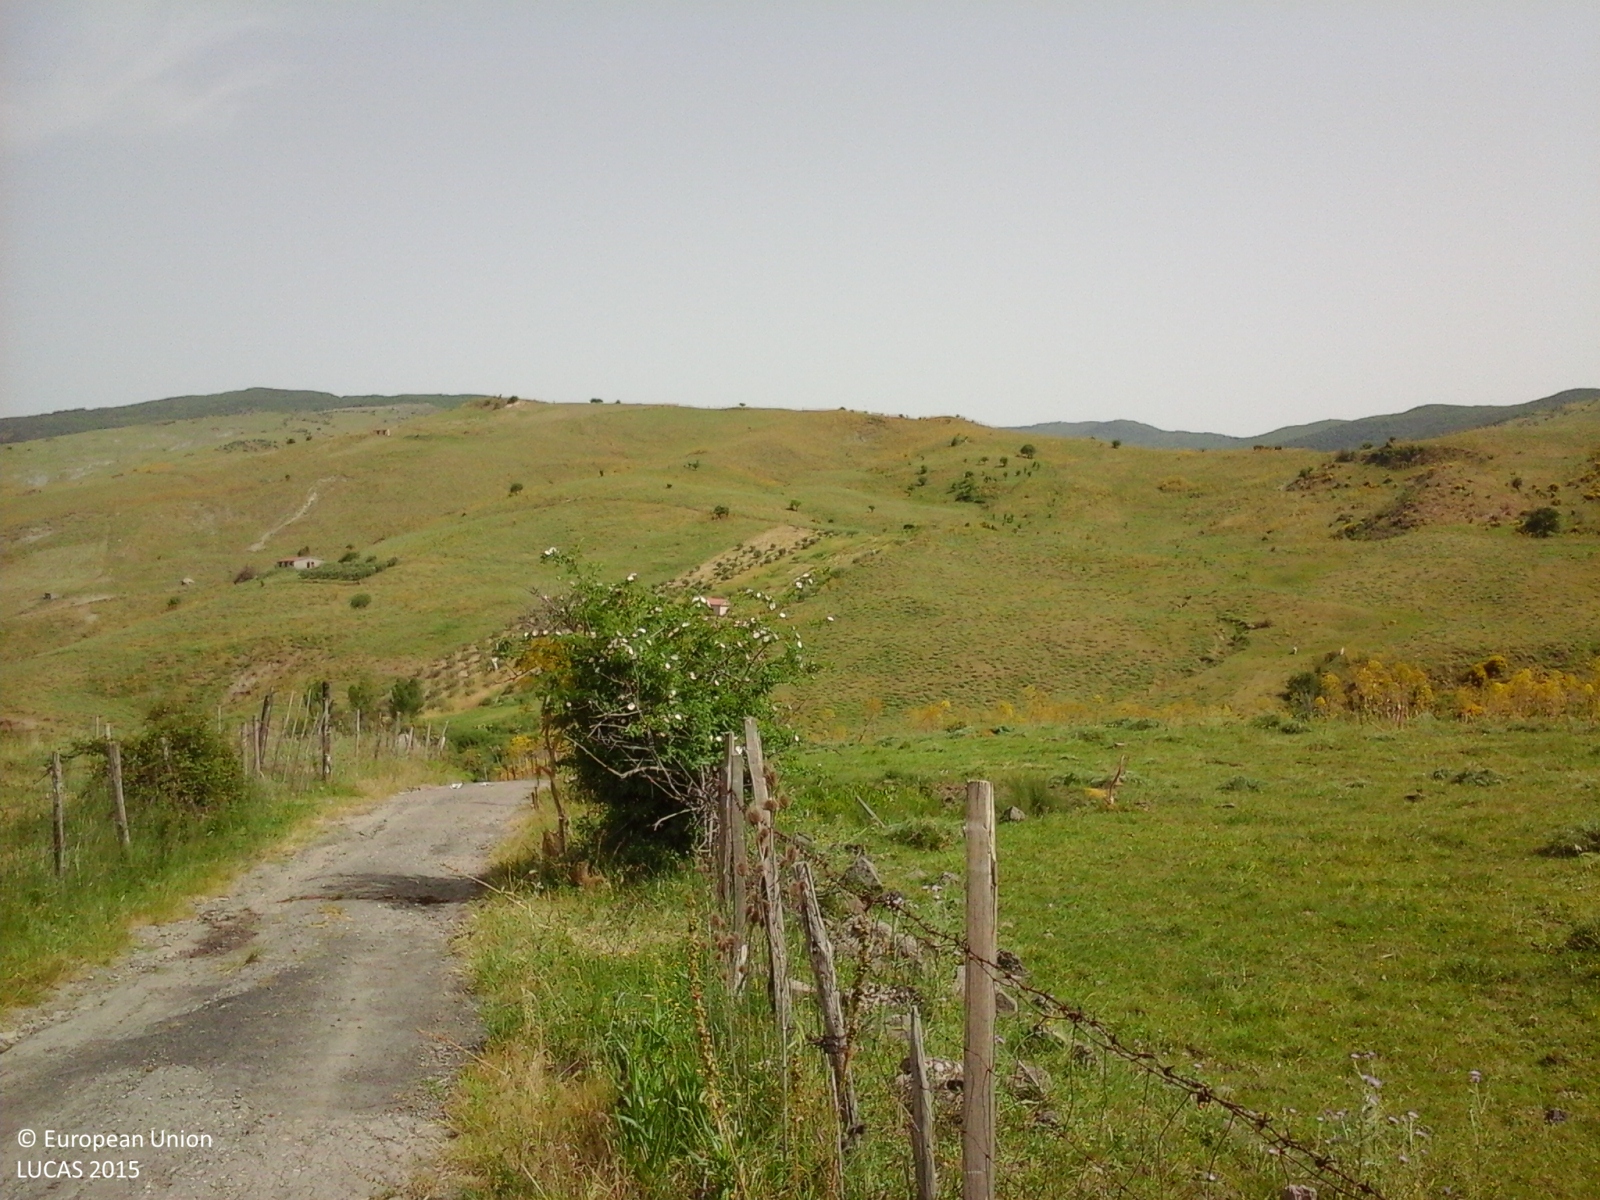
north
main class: Grassland
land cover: Grassland without tree/shrub cover
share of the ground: > 75 %
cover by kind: herbaceous plants 100 %
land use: Agriculture (excluding fallow land and kitchen gardens)
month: May
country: IT
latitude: 37.8605
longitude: 14.8430
